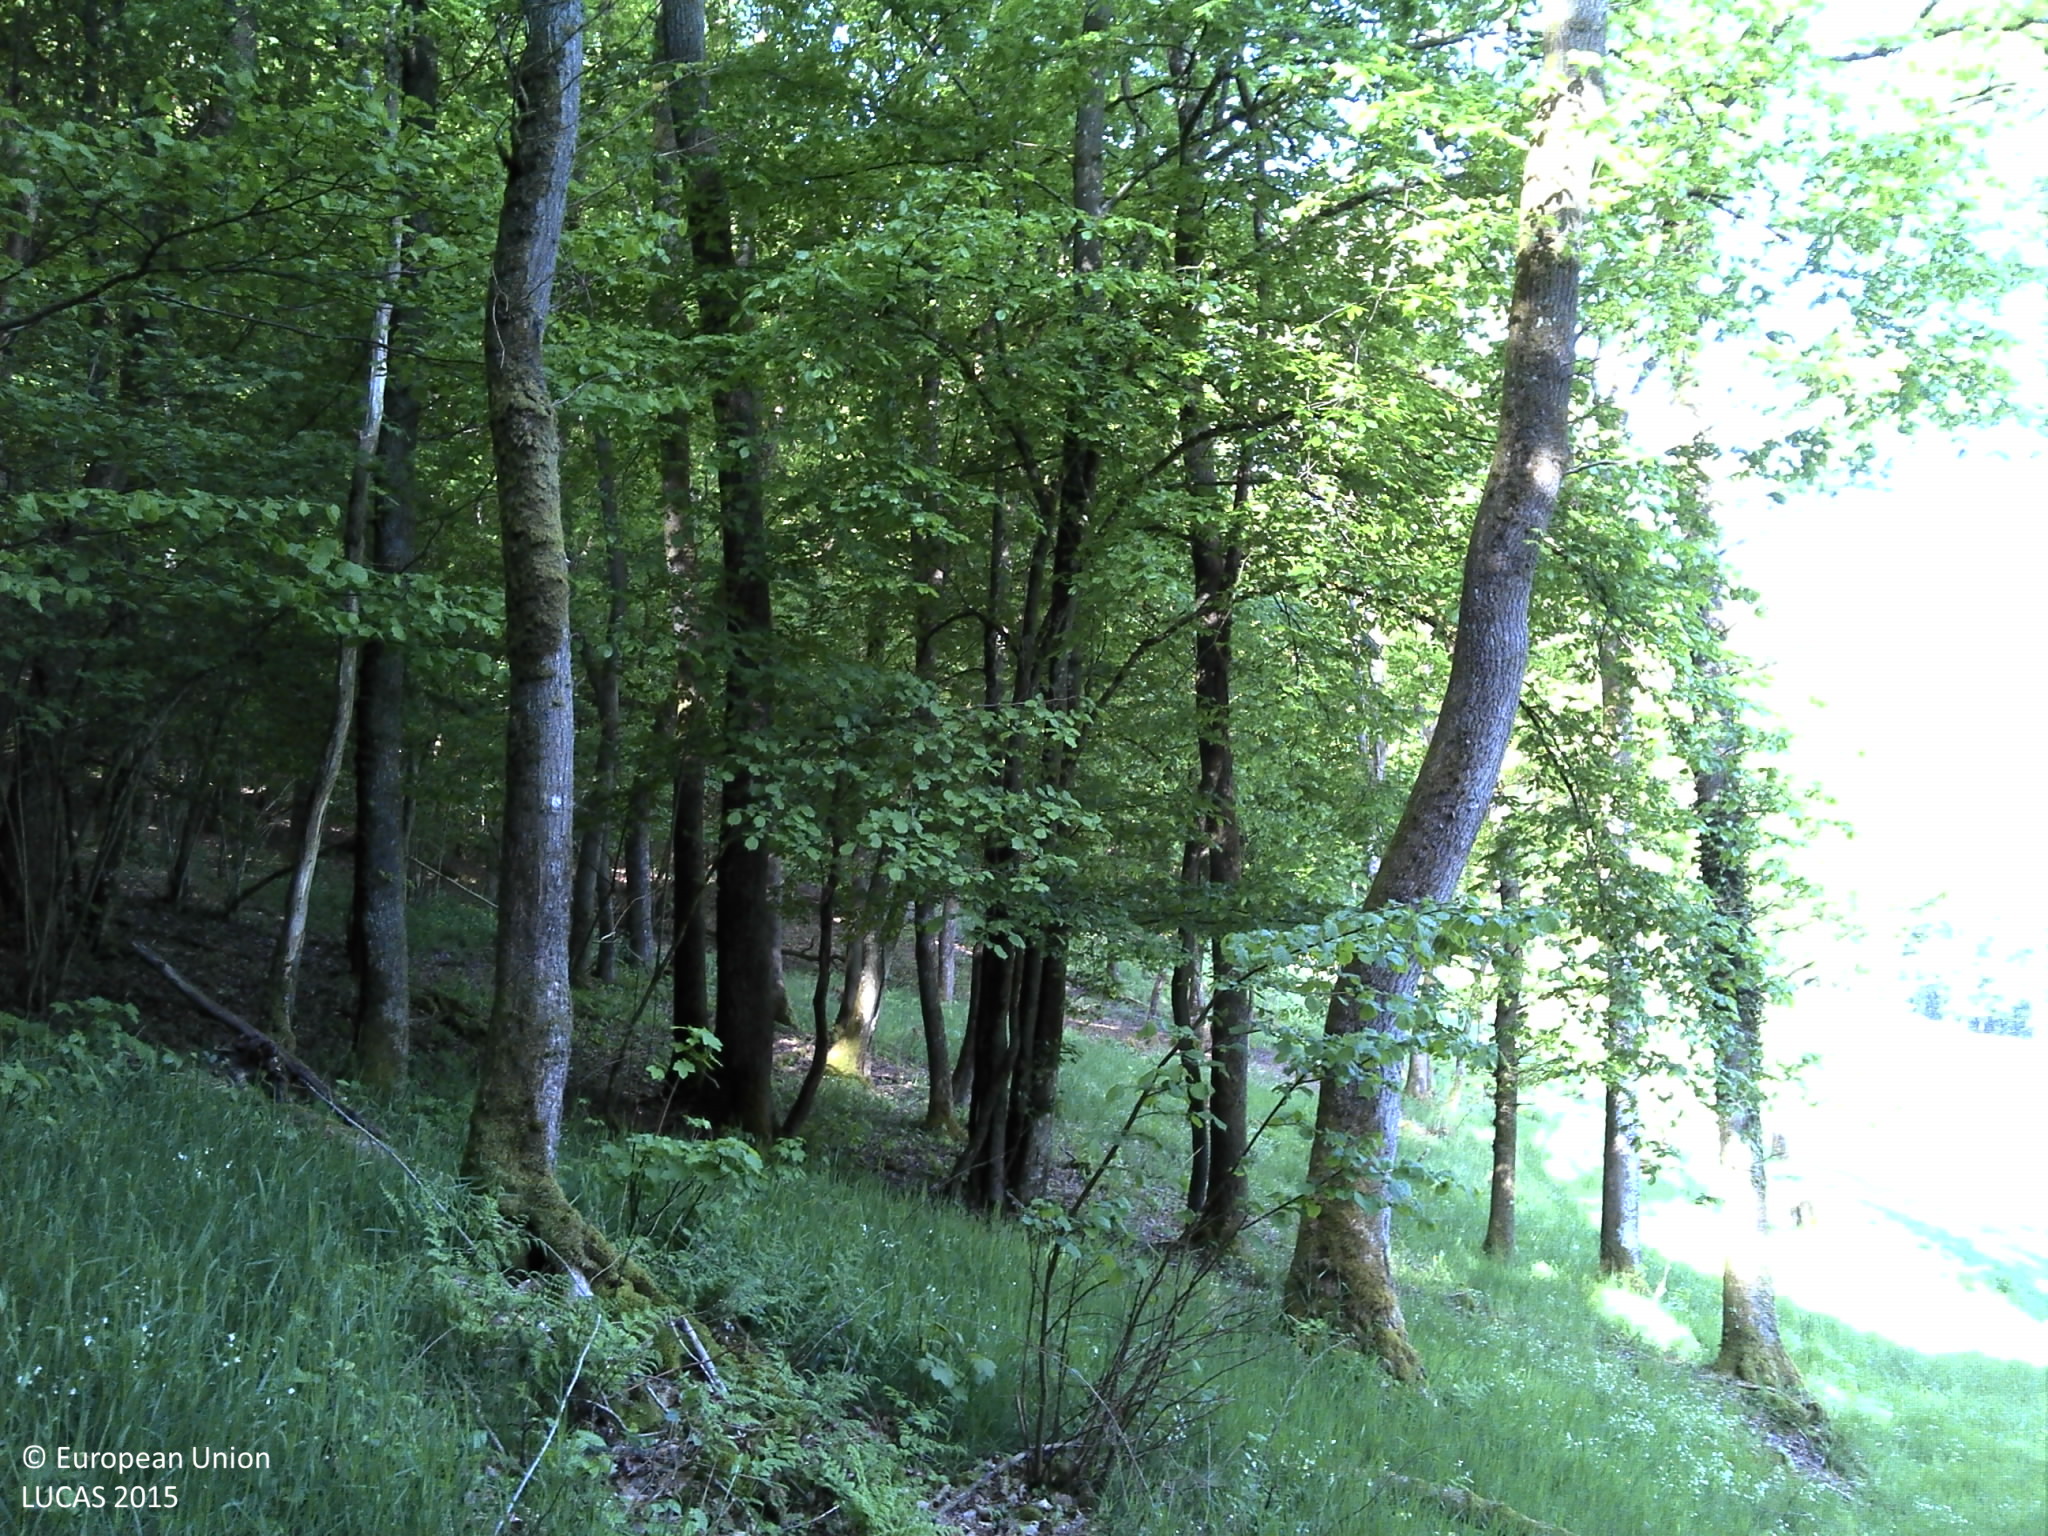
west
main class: Woodland
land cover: Broadleaved woodland
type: mesophytic deciduous forest
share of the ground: > 75 %
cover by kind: broadleaved forest trees 90 %, herbaceous plants 10 %
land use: Forestry
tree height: > 5 m
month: May
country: LU
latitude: 49.9181
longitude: 6.0578
